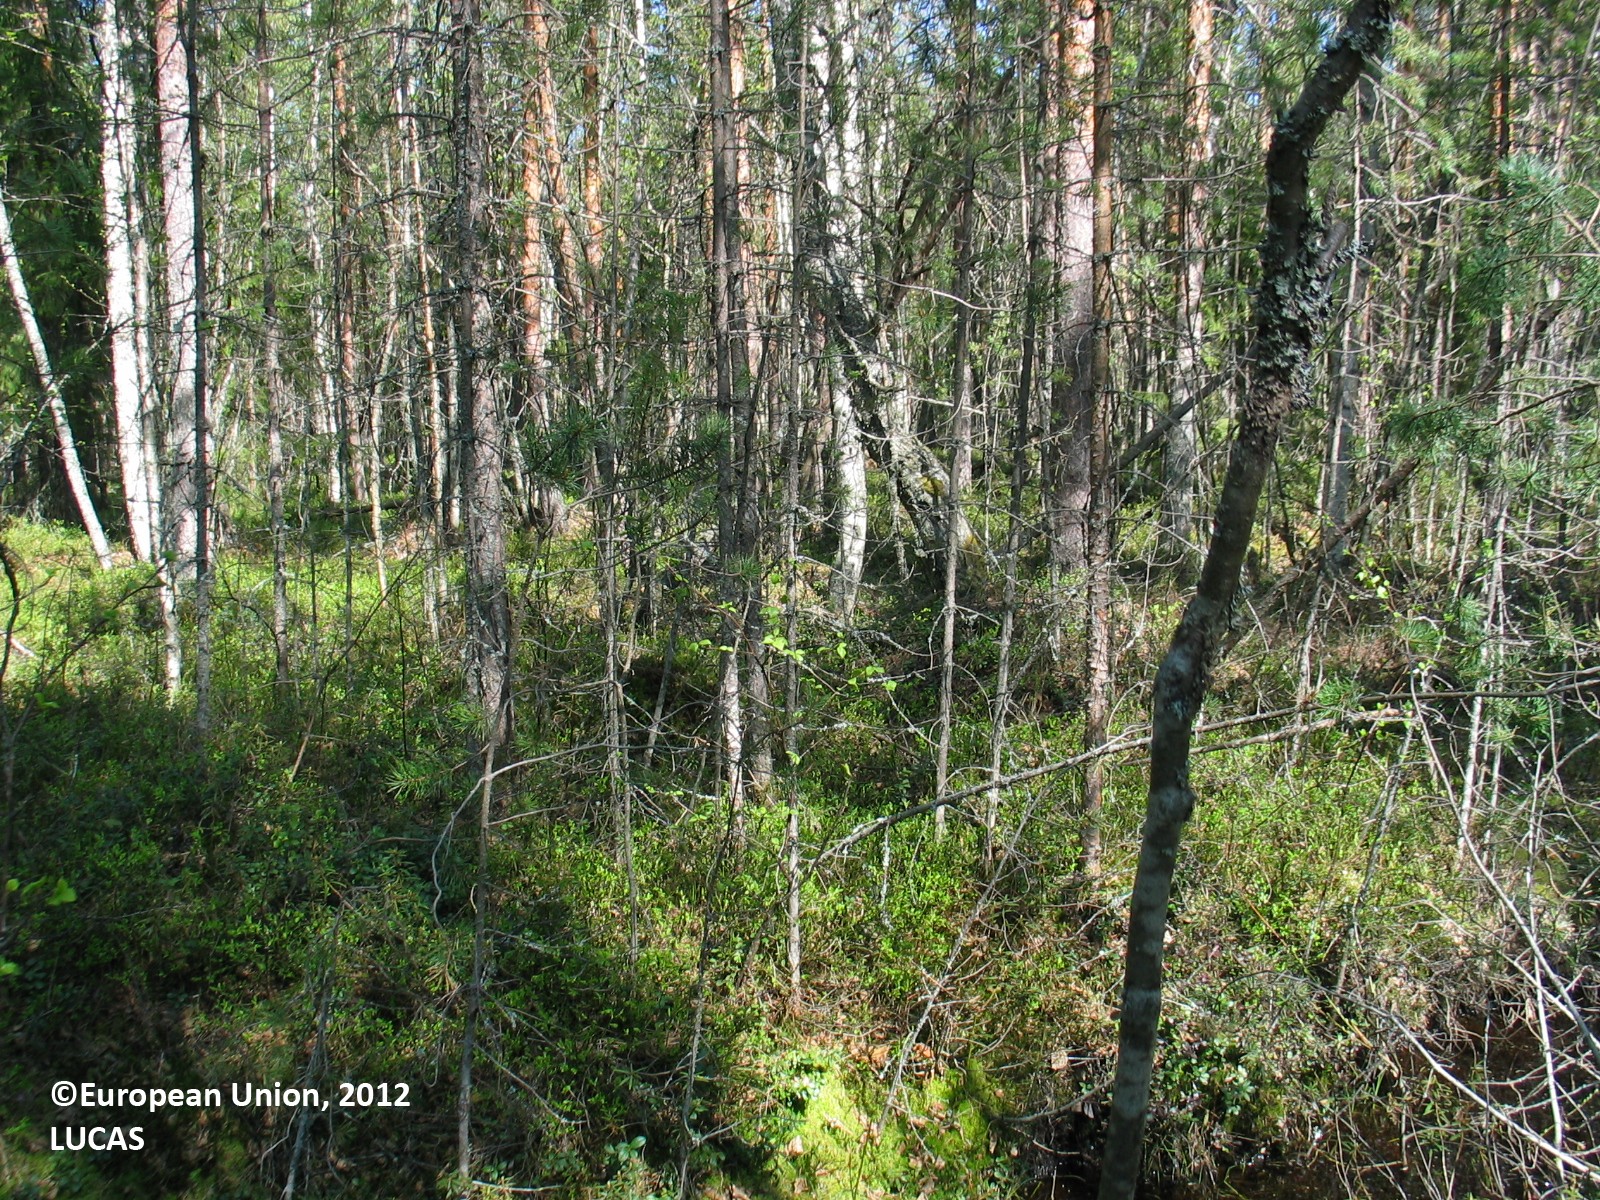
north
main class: Woodland
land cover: Other mixed woodland
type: mire and swamp forests
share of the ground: 50 - 75 %
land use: Forestry
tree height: > 5 m
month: May
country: FI
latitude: 64.9654
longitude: 25.2647
